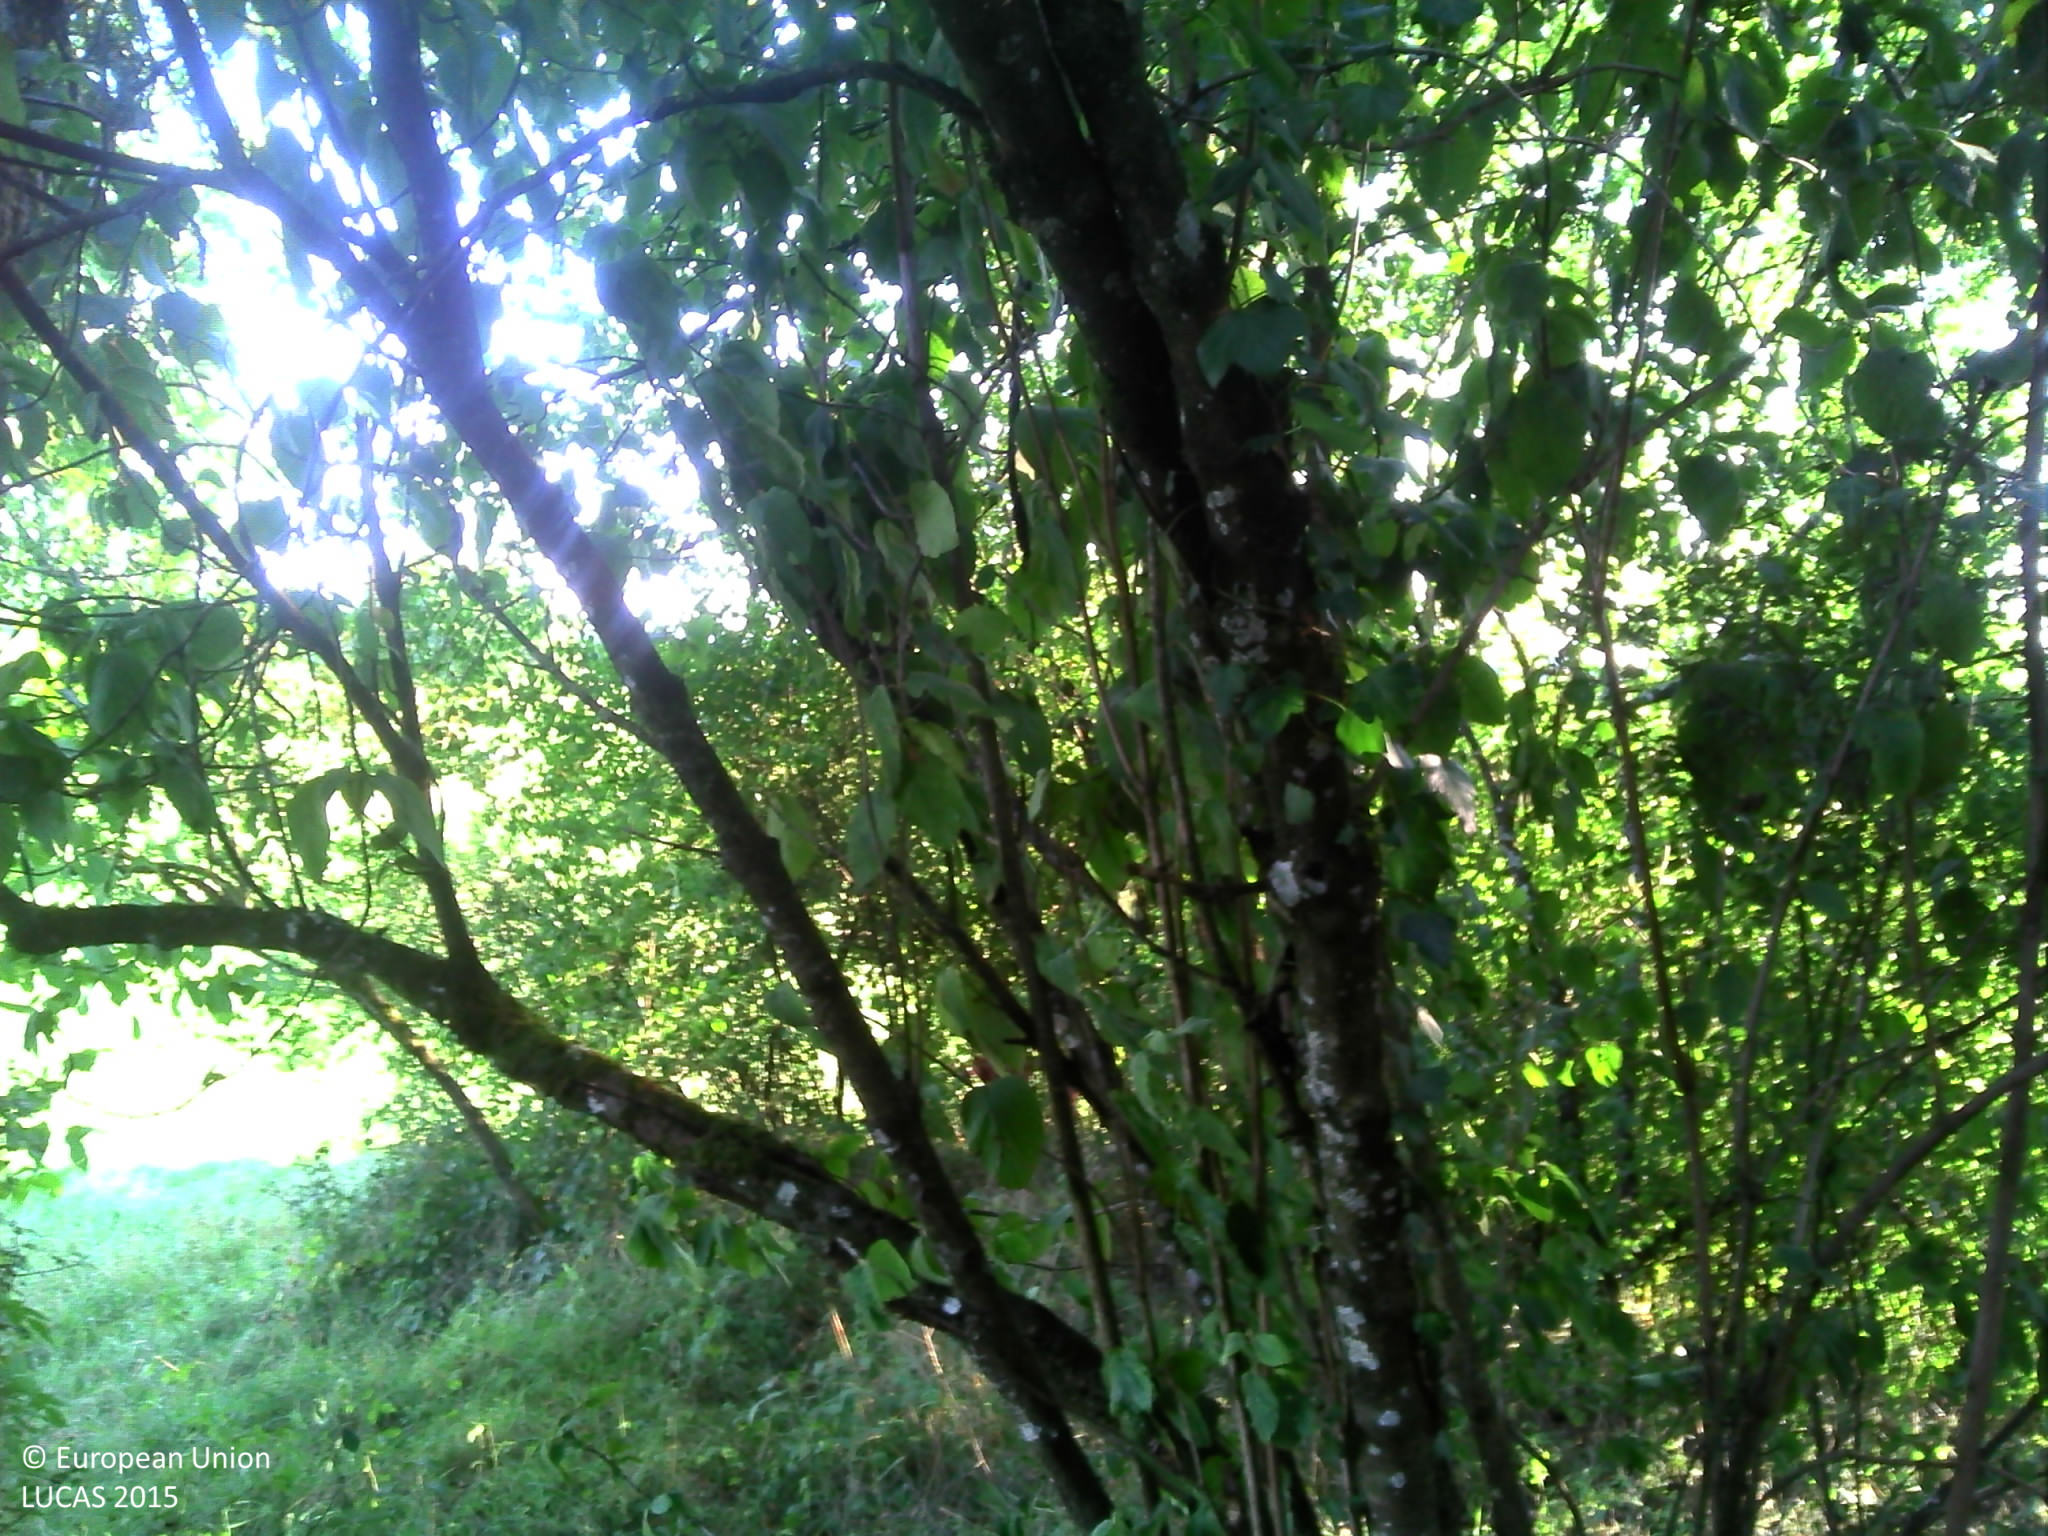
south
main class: Woodland
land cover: Broadleaved woodland
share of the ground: > 75 %
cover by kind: broadleaved forest trees 80 %, herbaceous plants 20 %
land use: Agriculture (excluding fallow land and kitchen gardens)
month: September
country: FR
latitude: 47.3150
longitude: 6.3109
